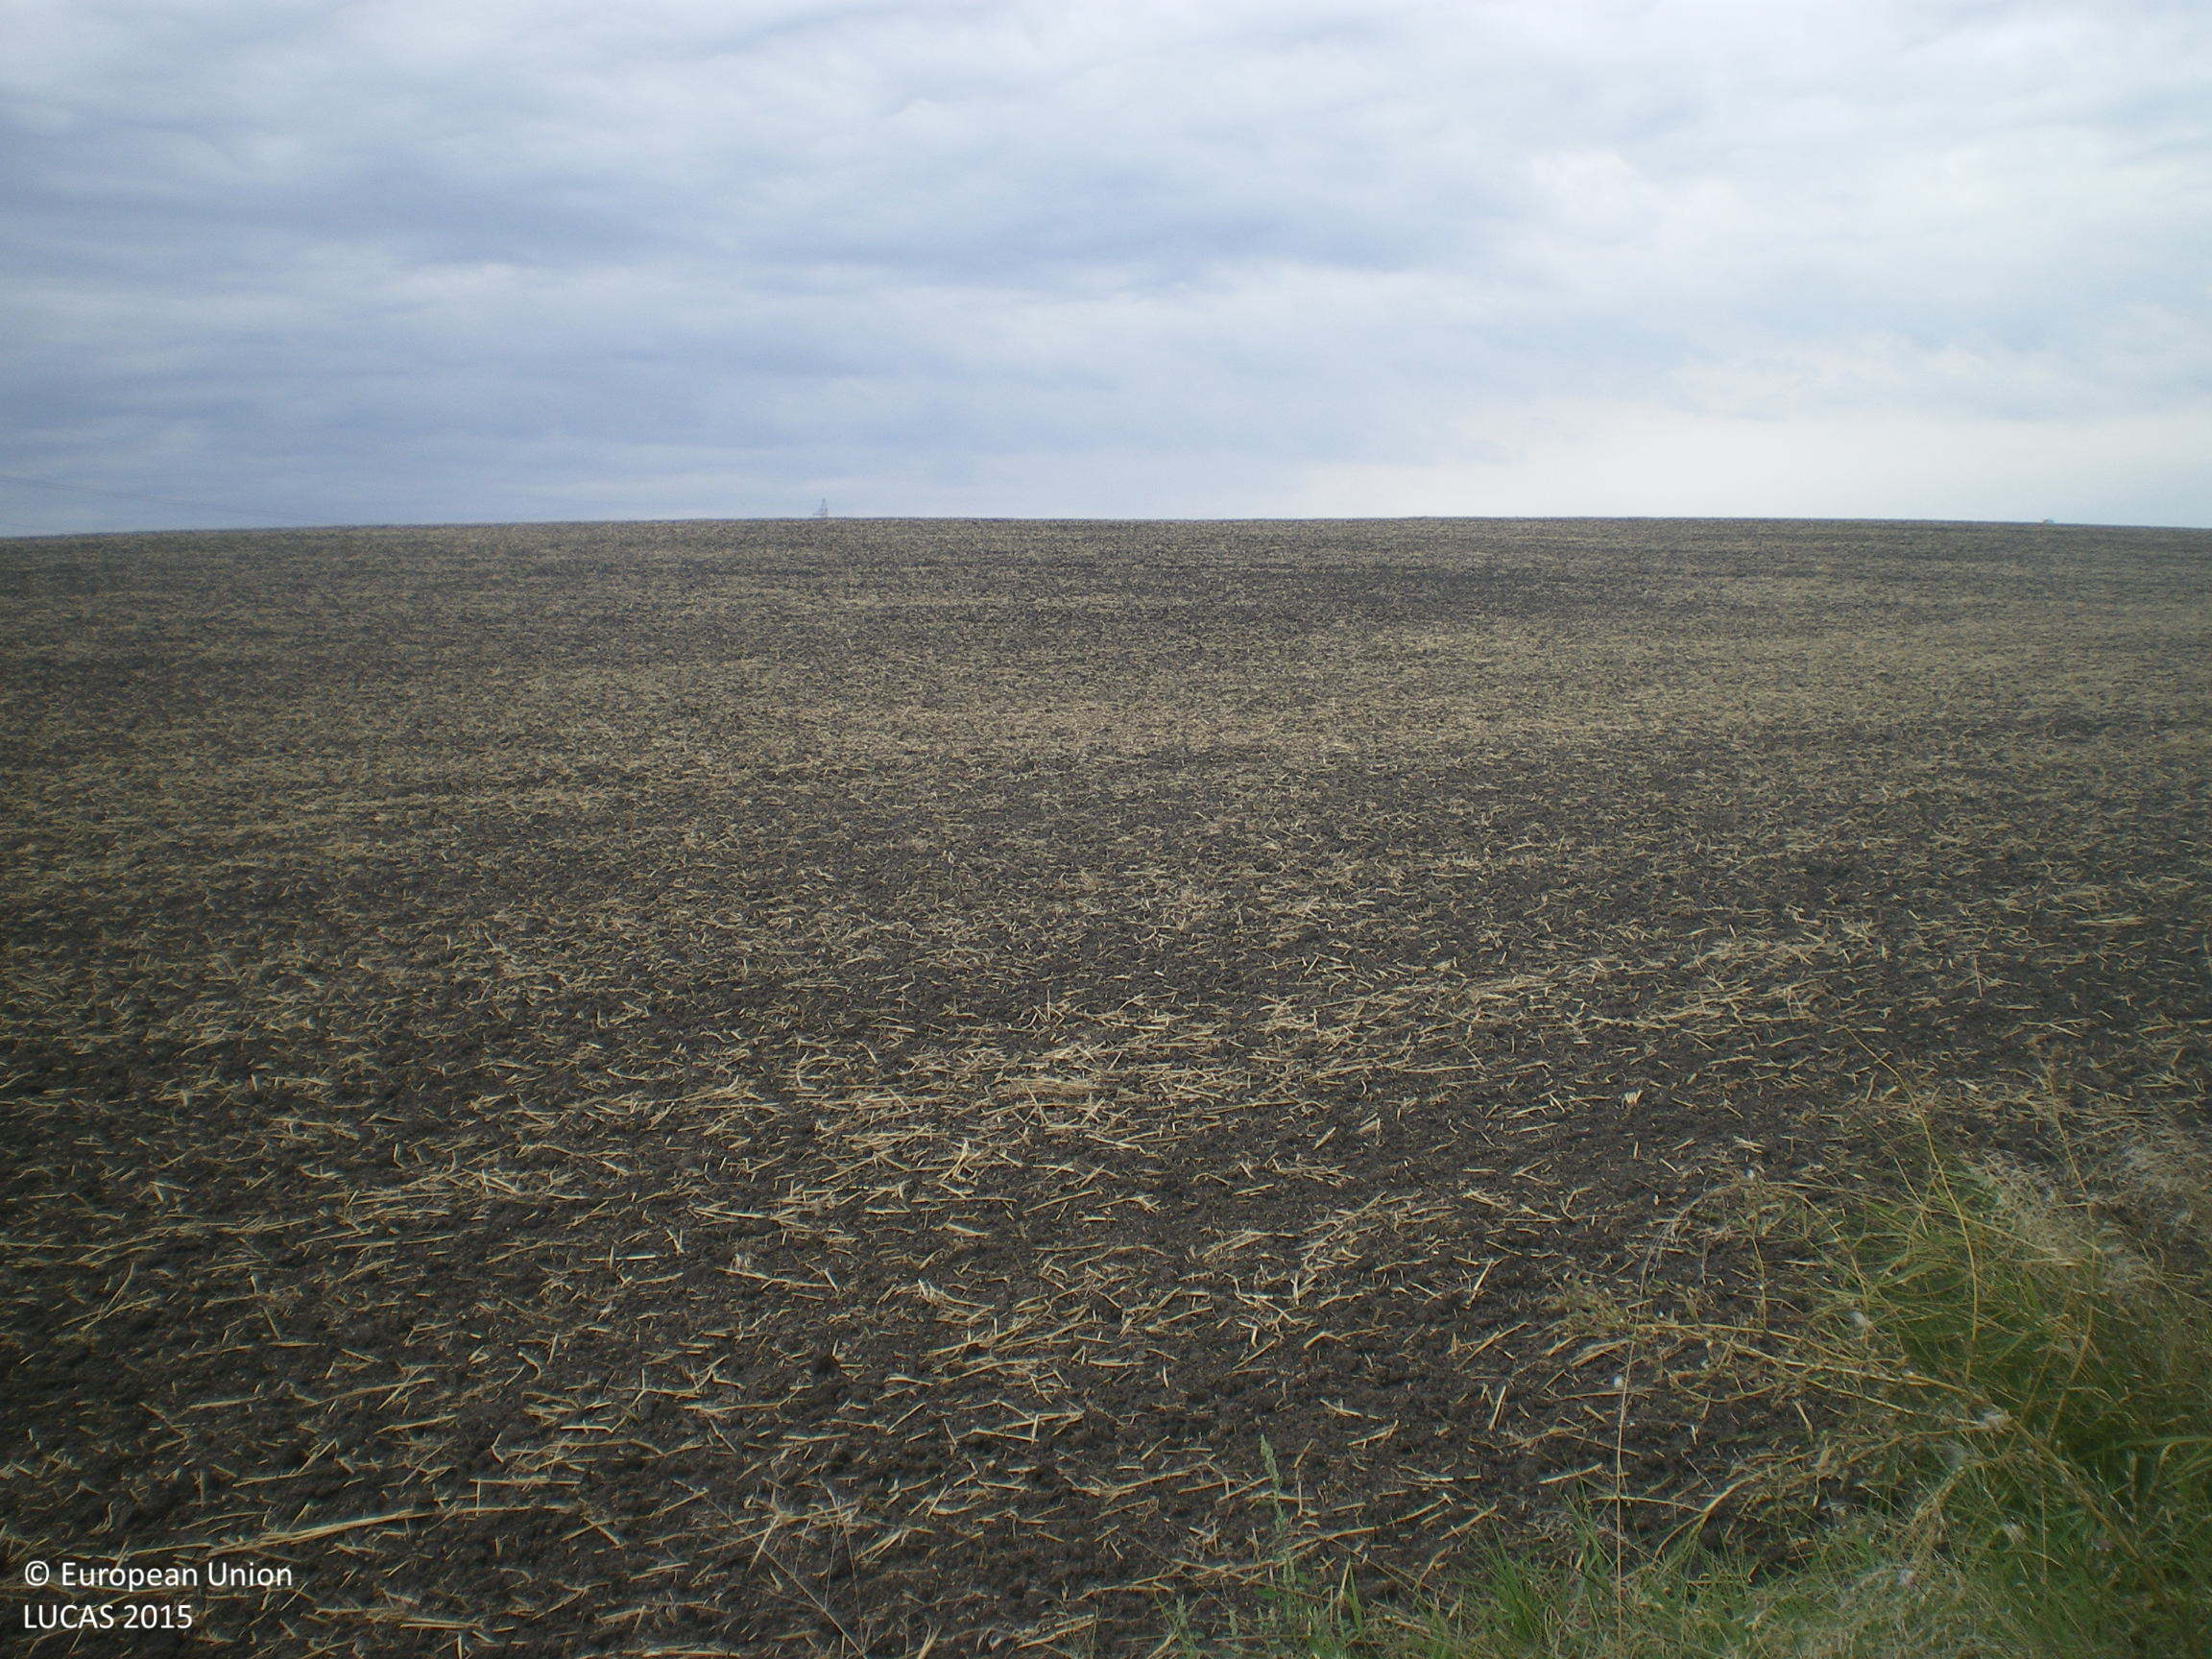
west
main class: Grassland
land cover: Grassland without tree/shrub cover
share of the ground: > 75 %
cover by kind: herbaceous plants 100 %
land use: Agriculture (excluding fallow land and kitchen gardens)
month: September
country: BG
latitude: 42.2066
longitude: 25.9550
